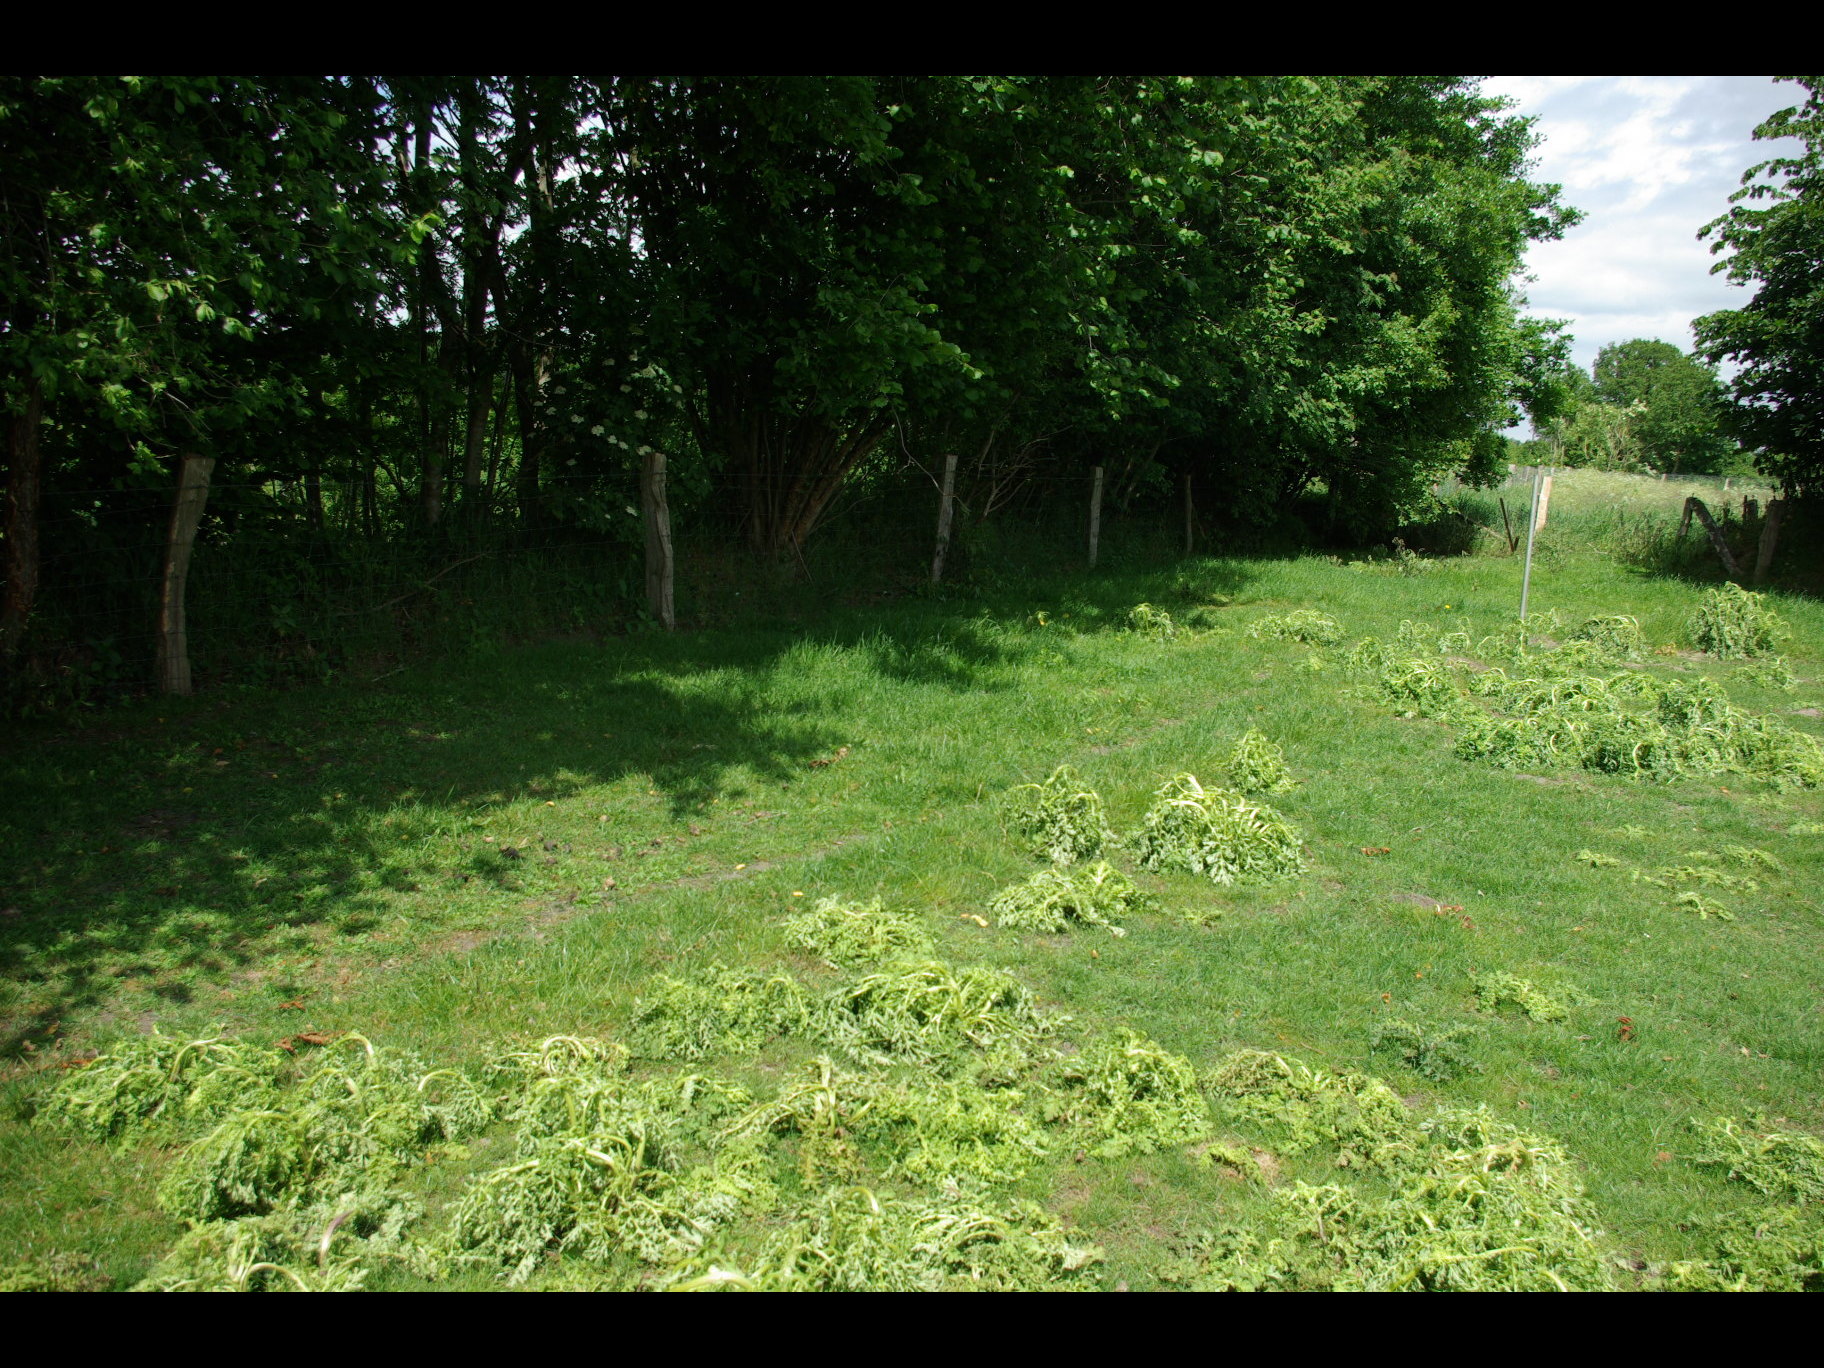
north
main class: Grassland
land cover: Grassland without tree/shrub cover
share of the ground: > 75 %
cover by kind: herbaceous plants 80 %, unconsolidated bare surface 20 %
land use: Agriculture (excluding fallow land and kitchen gardens)
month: June
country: DE
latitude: 54.0848
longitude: 9.8931
